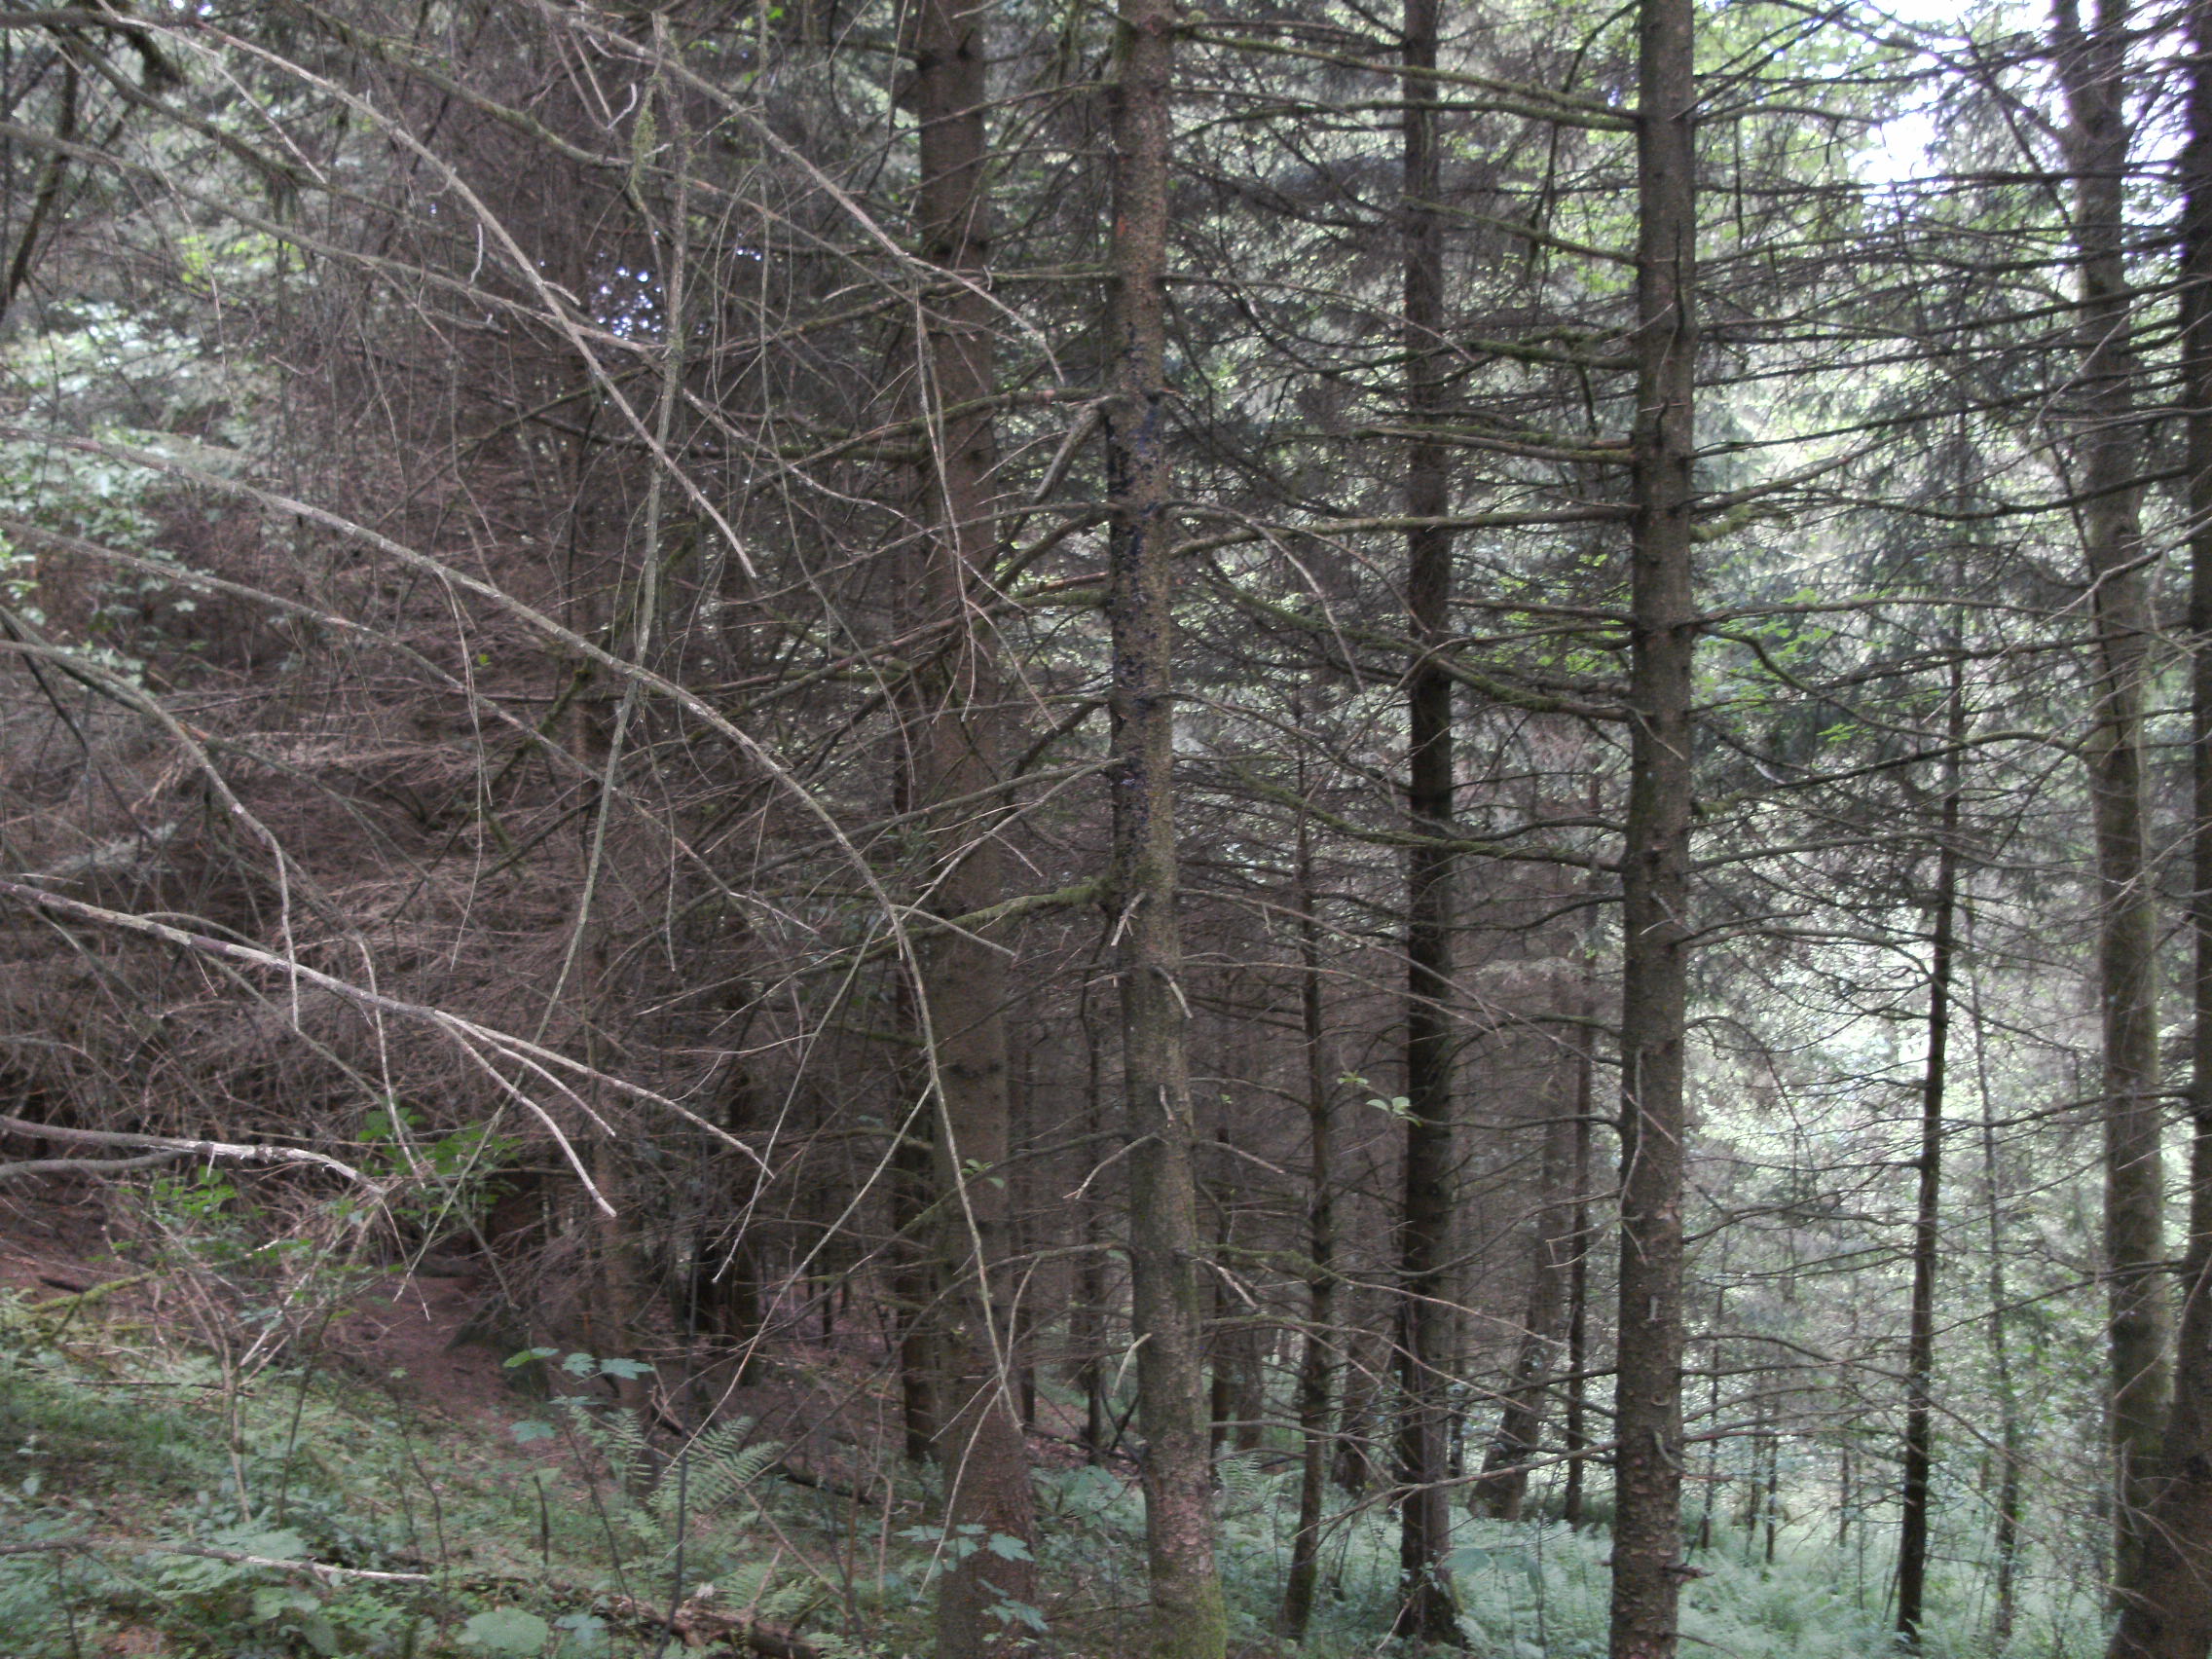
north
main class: Woodland
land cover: Spruce dominated coniferous woodland
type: hemiboreal forest and nemoral coniferous forest and mixed broadleaved-coniferous forest
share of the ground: > 75 %
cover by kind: coniferous forest trees 95 %, herbaceous plants 5 %
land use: Forestry
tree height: > 5 m
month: May
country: AT
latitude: 48.4841
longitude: 13.7474
